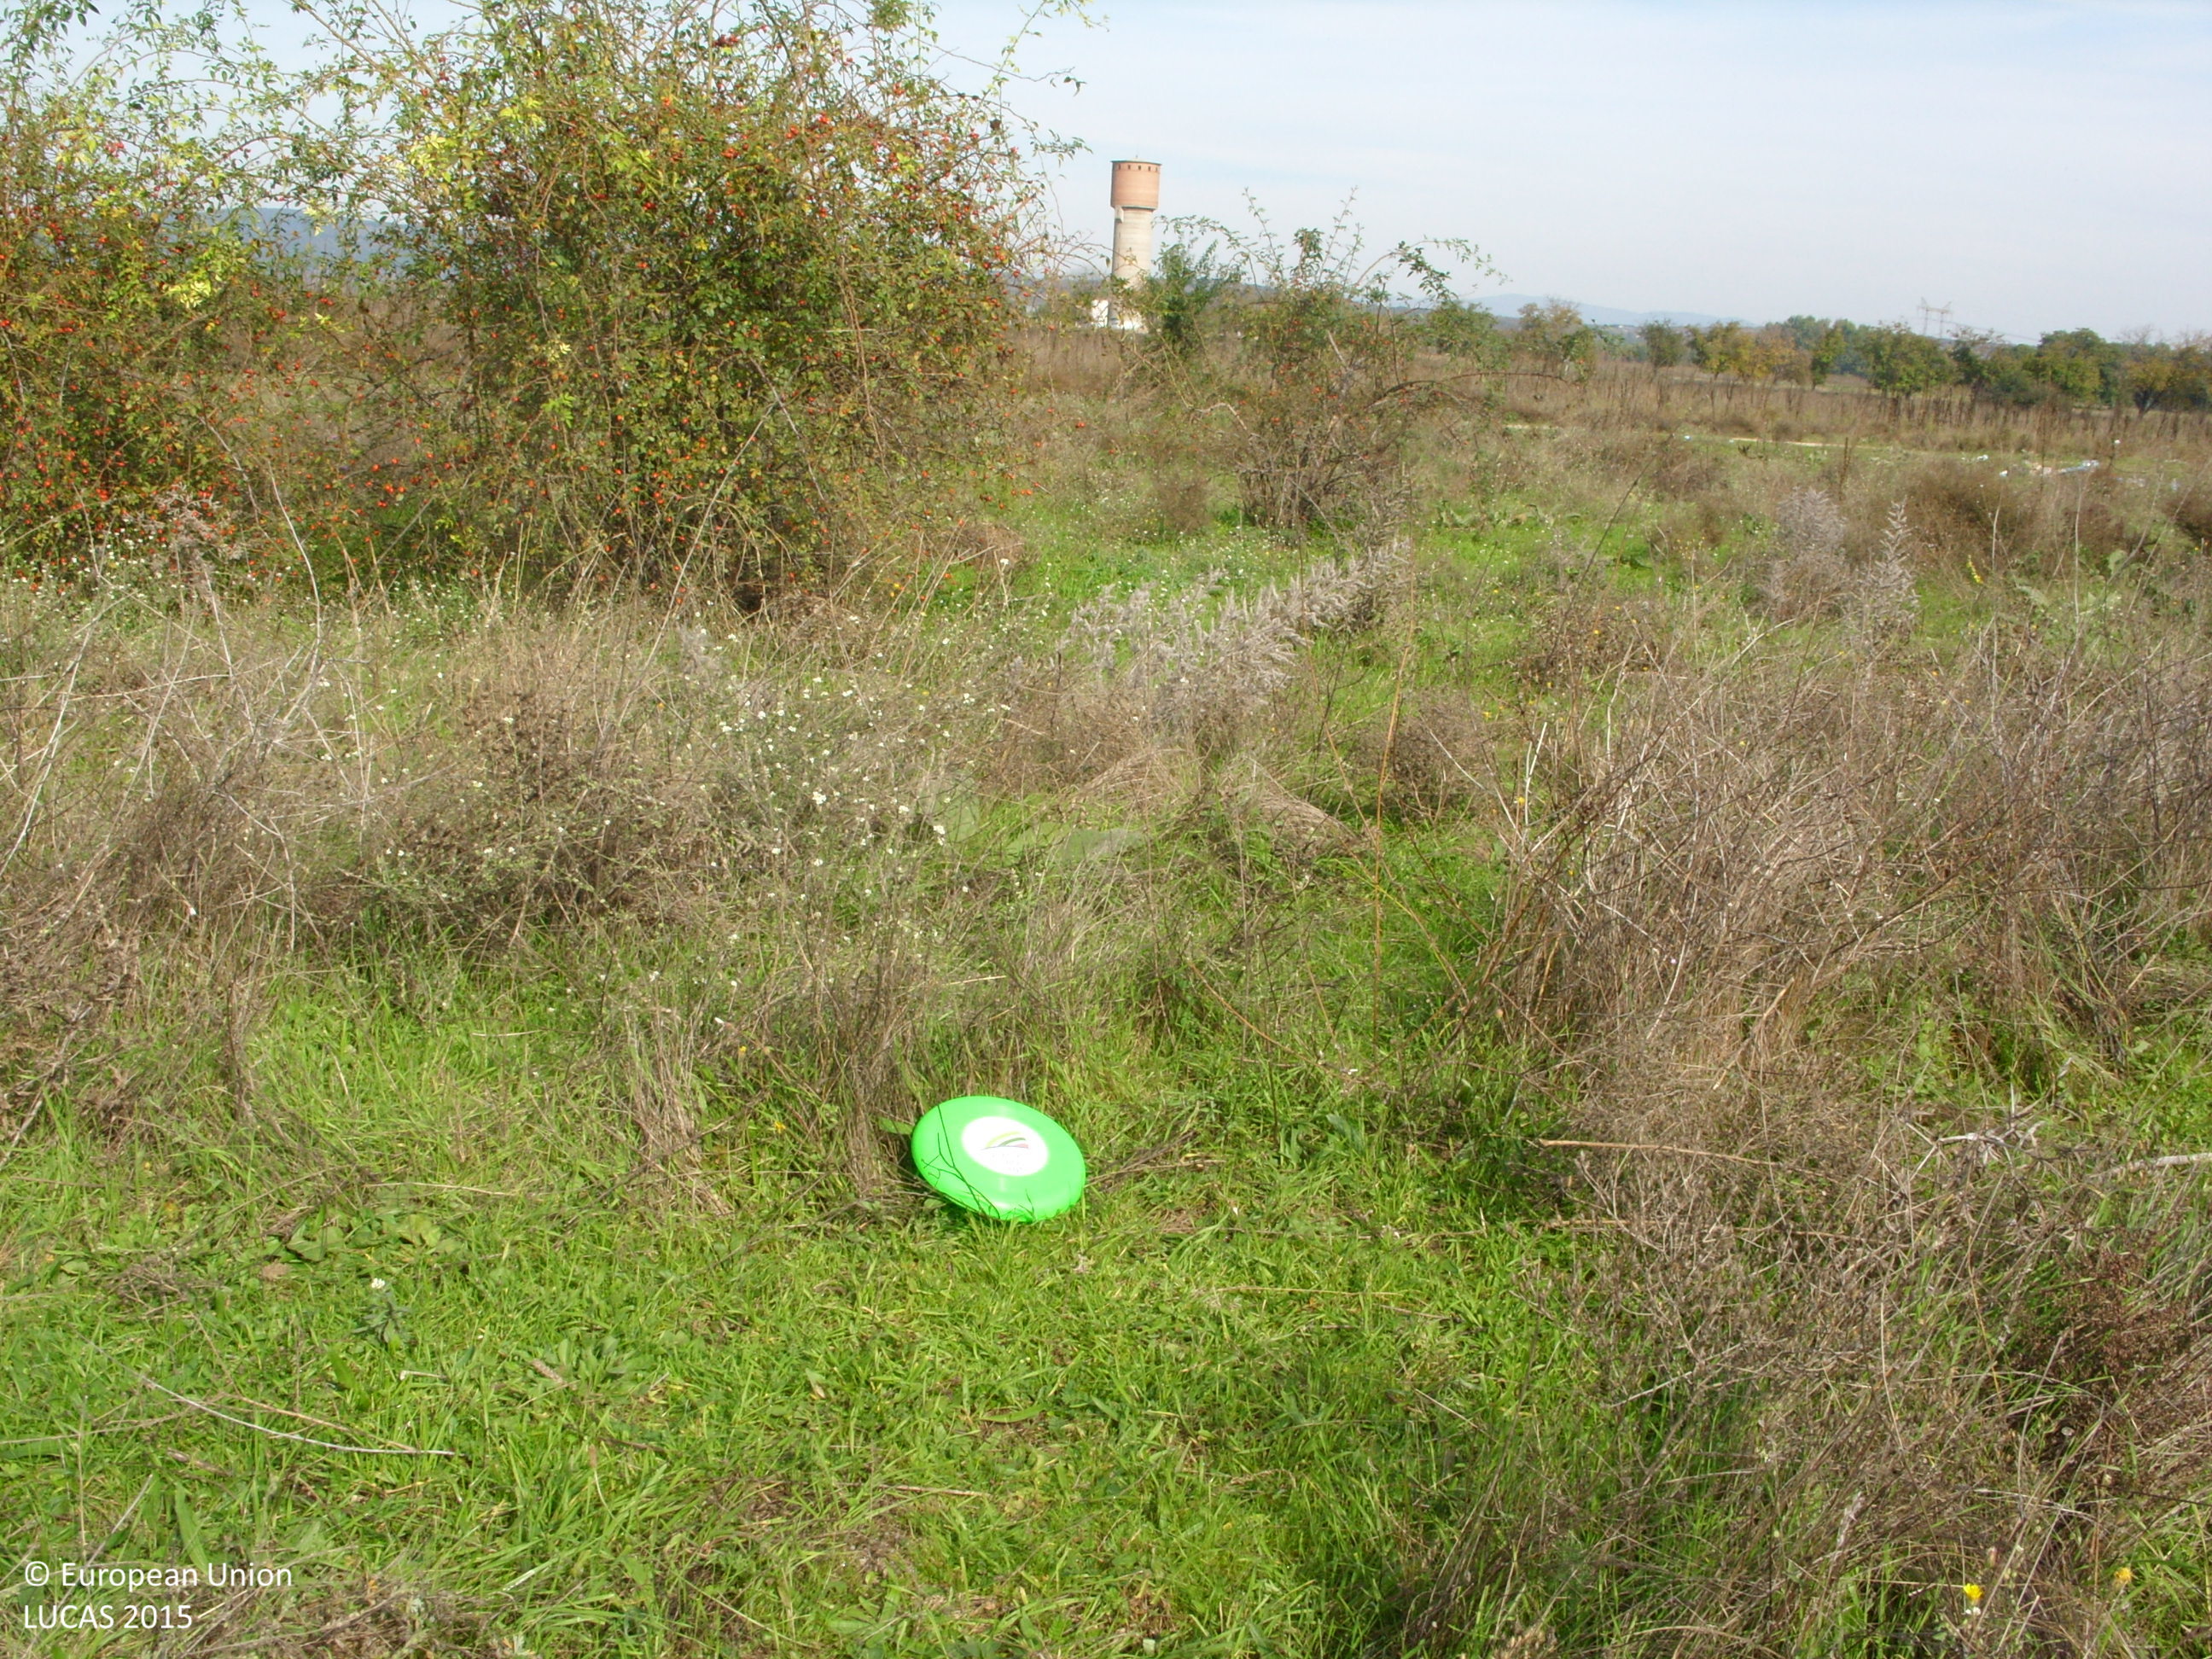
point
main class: Grassland
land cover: Grassland with sparse tree/shrub cover
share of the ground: > 75 %
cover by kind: herbaceous plants 85 %, shrubs 10 %, broadleaved forest trees 5 %
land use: Fallow land
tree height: < 5 m
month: October
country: BG
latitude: 42.2284
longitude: 24.1084
